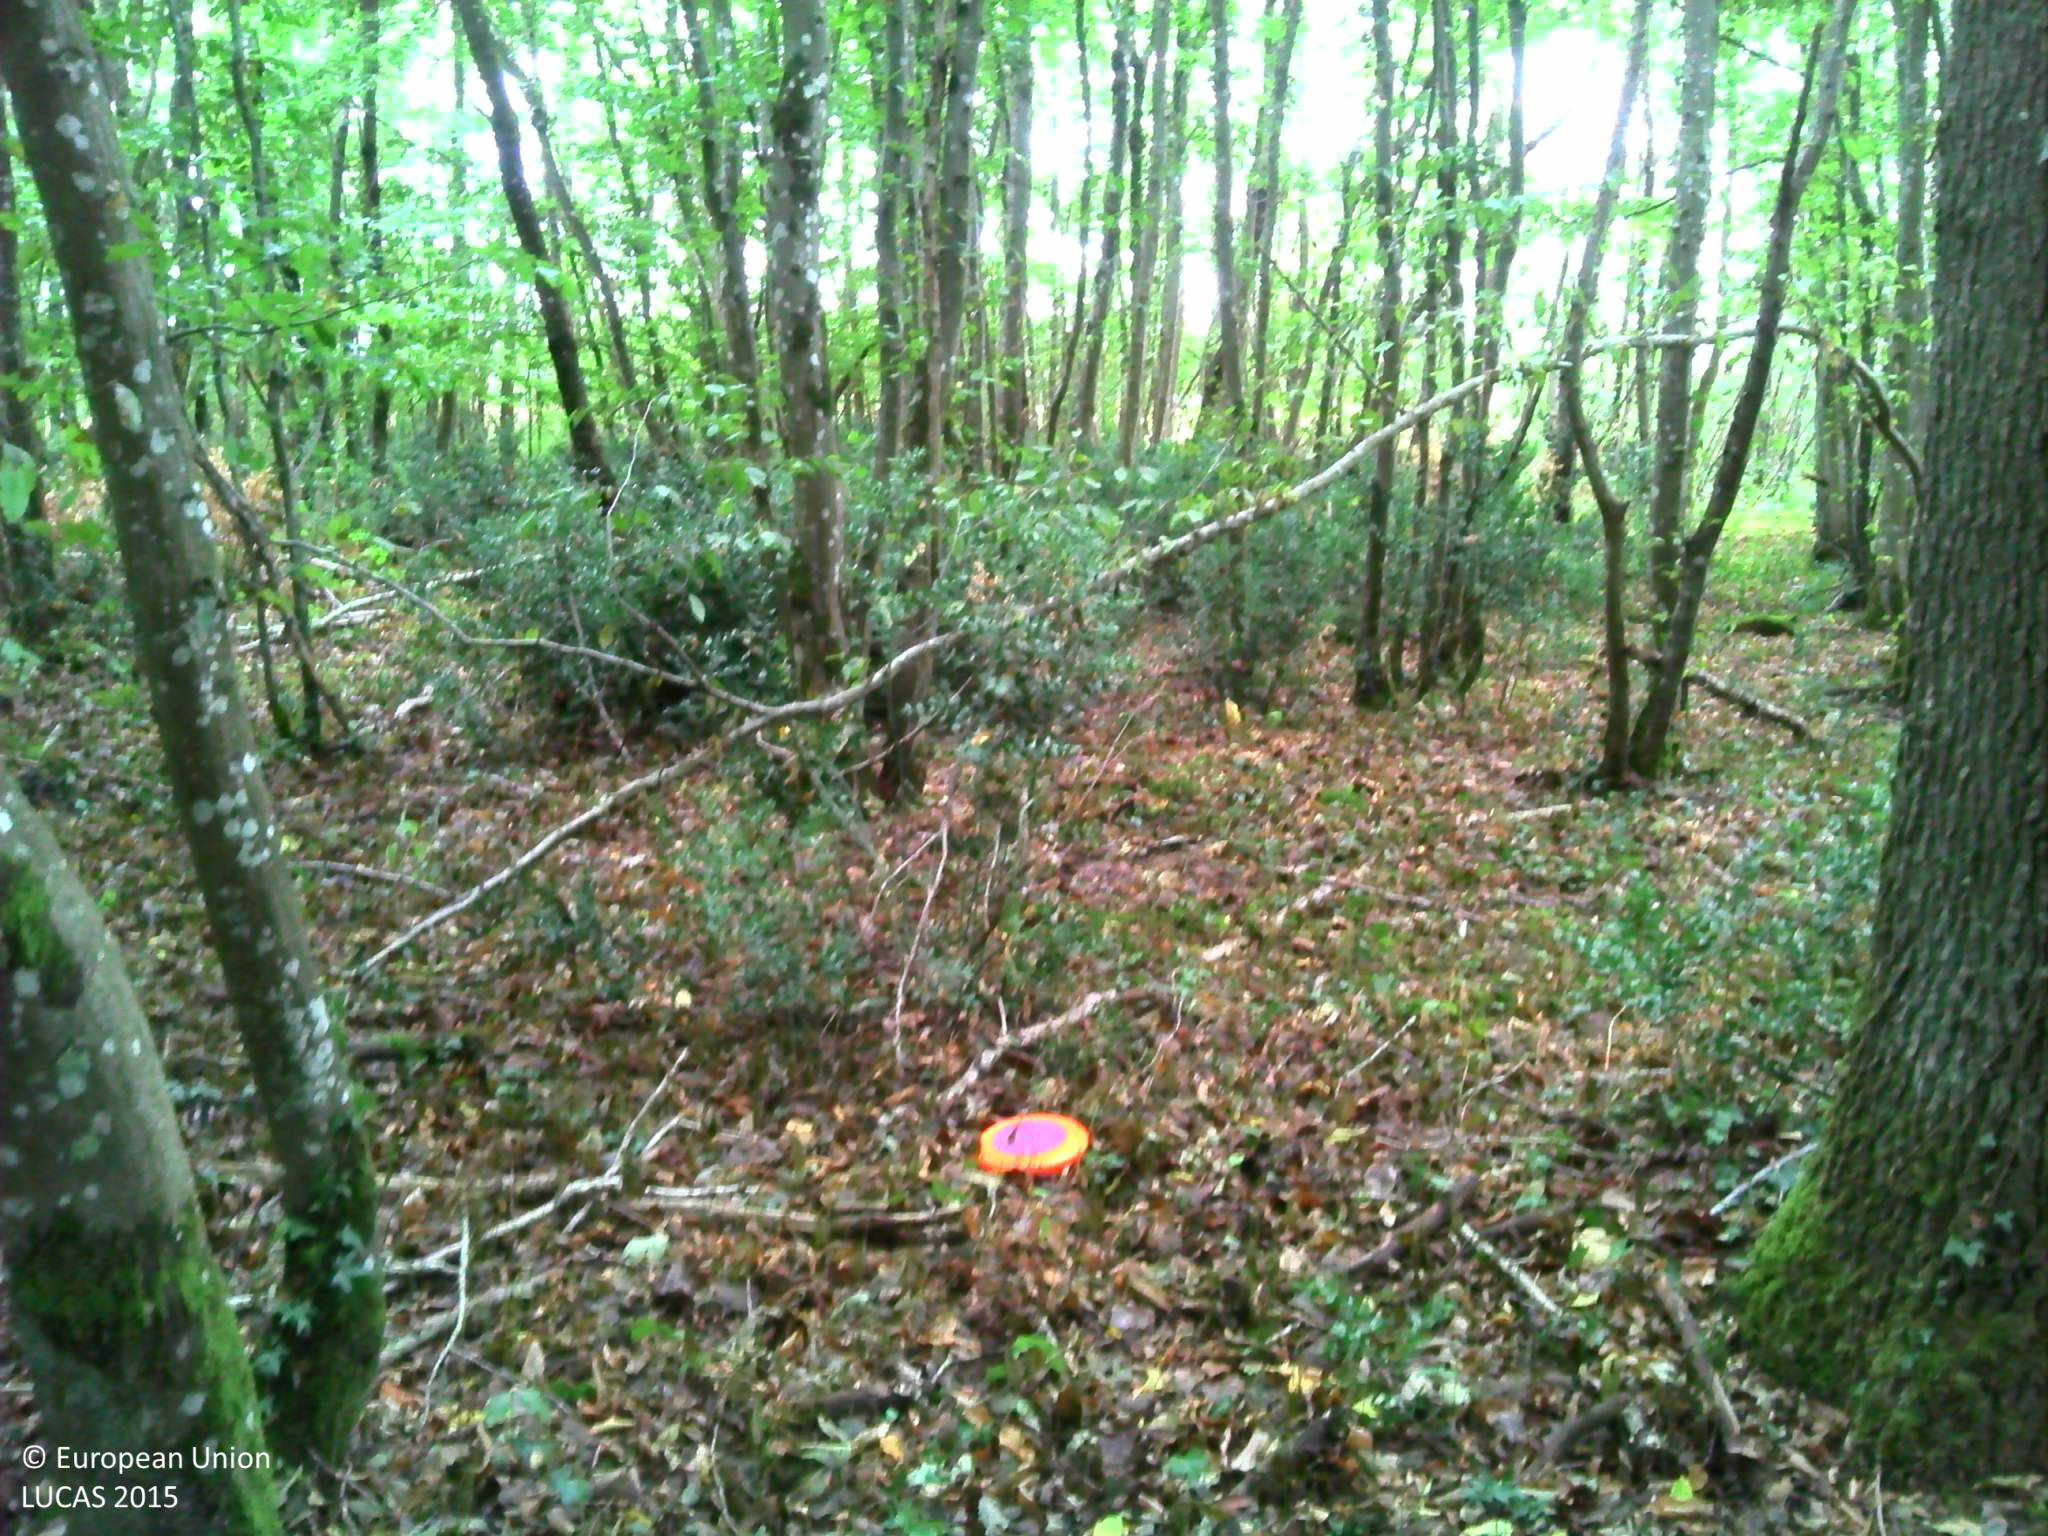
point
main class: Woodland
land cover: Broadleaved woodland
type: acidophilous oak and oak-birch forest
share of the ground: > 75 %
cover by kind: broadleaved forest trees 60 %, unconsolidated bare surface 30 %, herbaceous plants 10 %
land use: Forestry
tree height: > 5 m
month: August
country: FR
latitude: 48.1327
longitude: 2.8029
